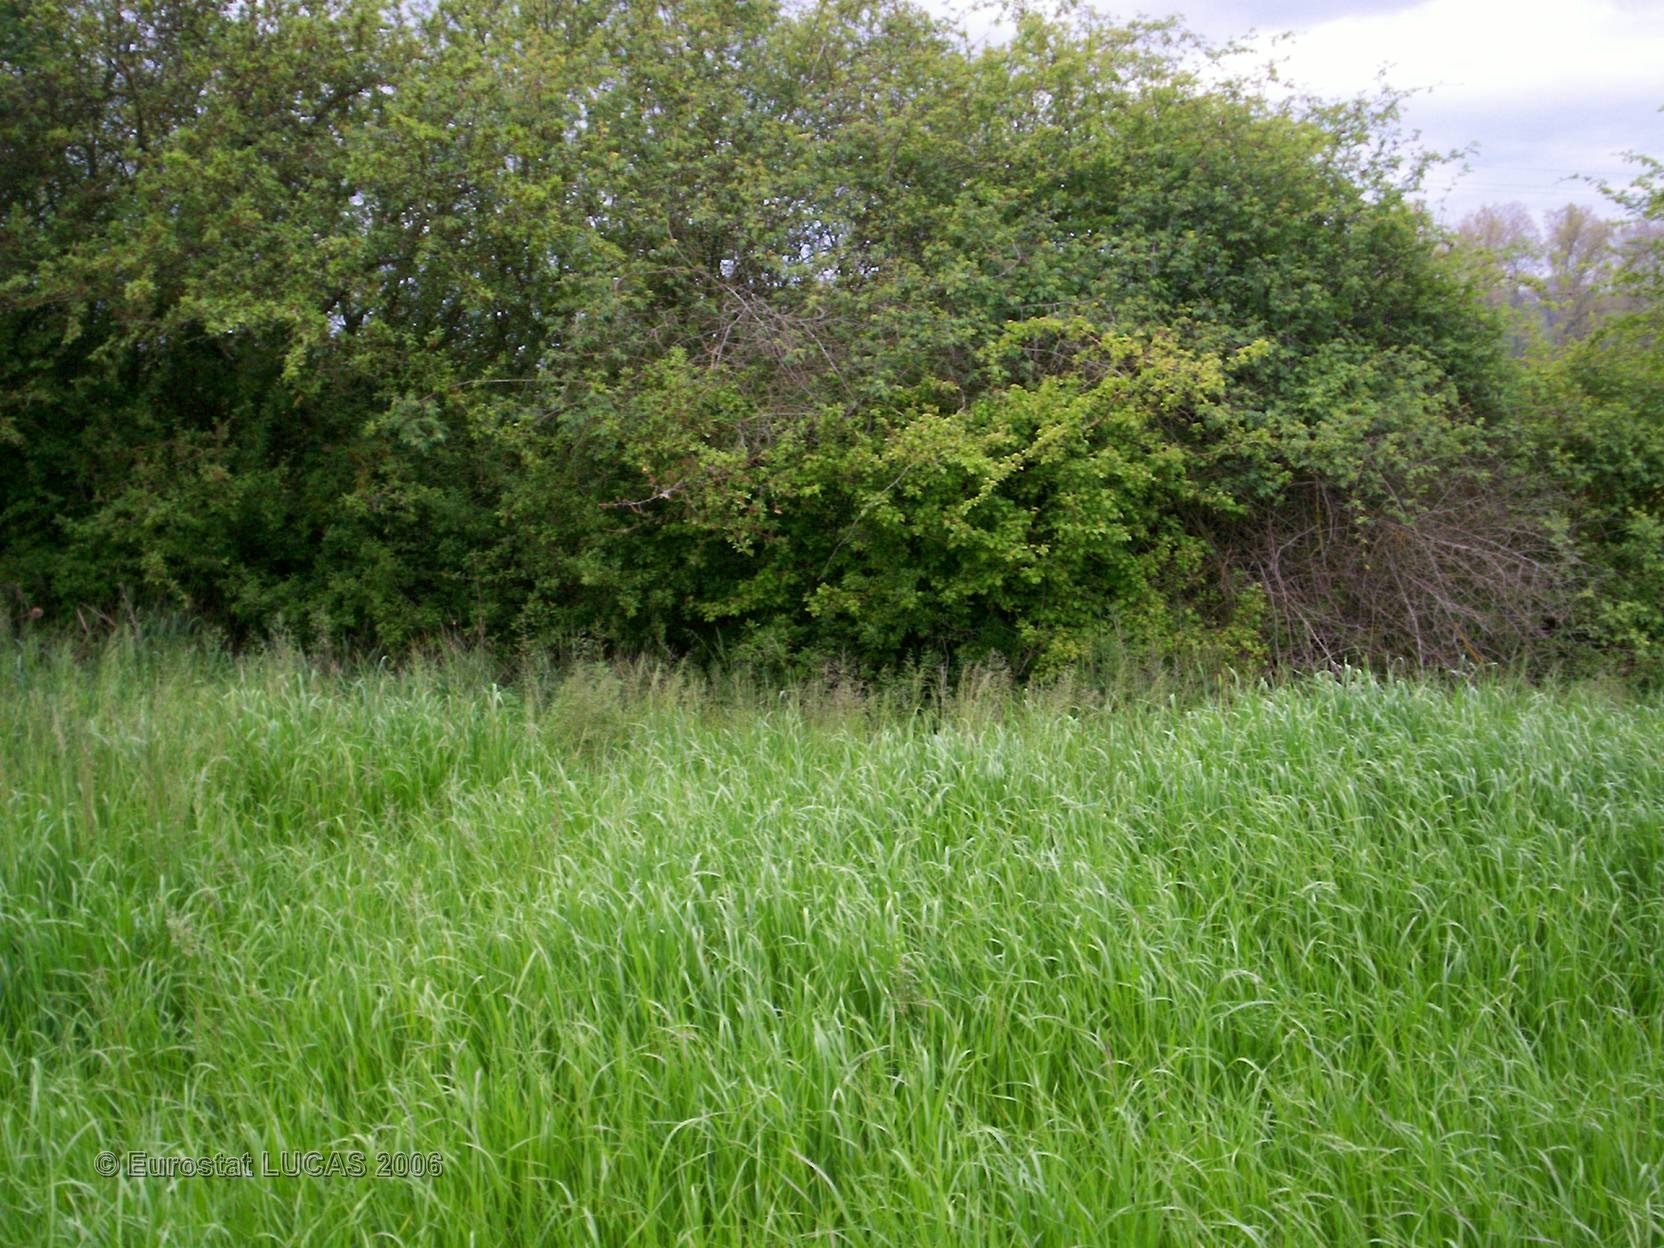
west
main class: Grassland
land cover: Grassland without tree/shrub cover
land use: Agriculture (excluding fallow land and kitchen gardens)
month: April
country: FR
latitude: 43.7293
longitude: 0.2745
